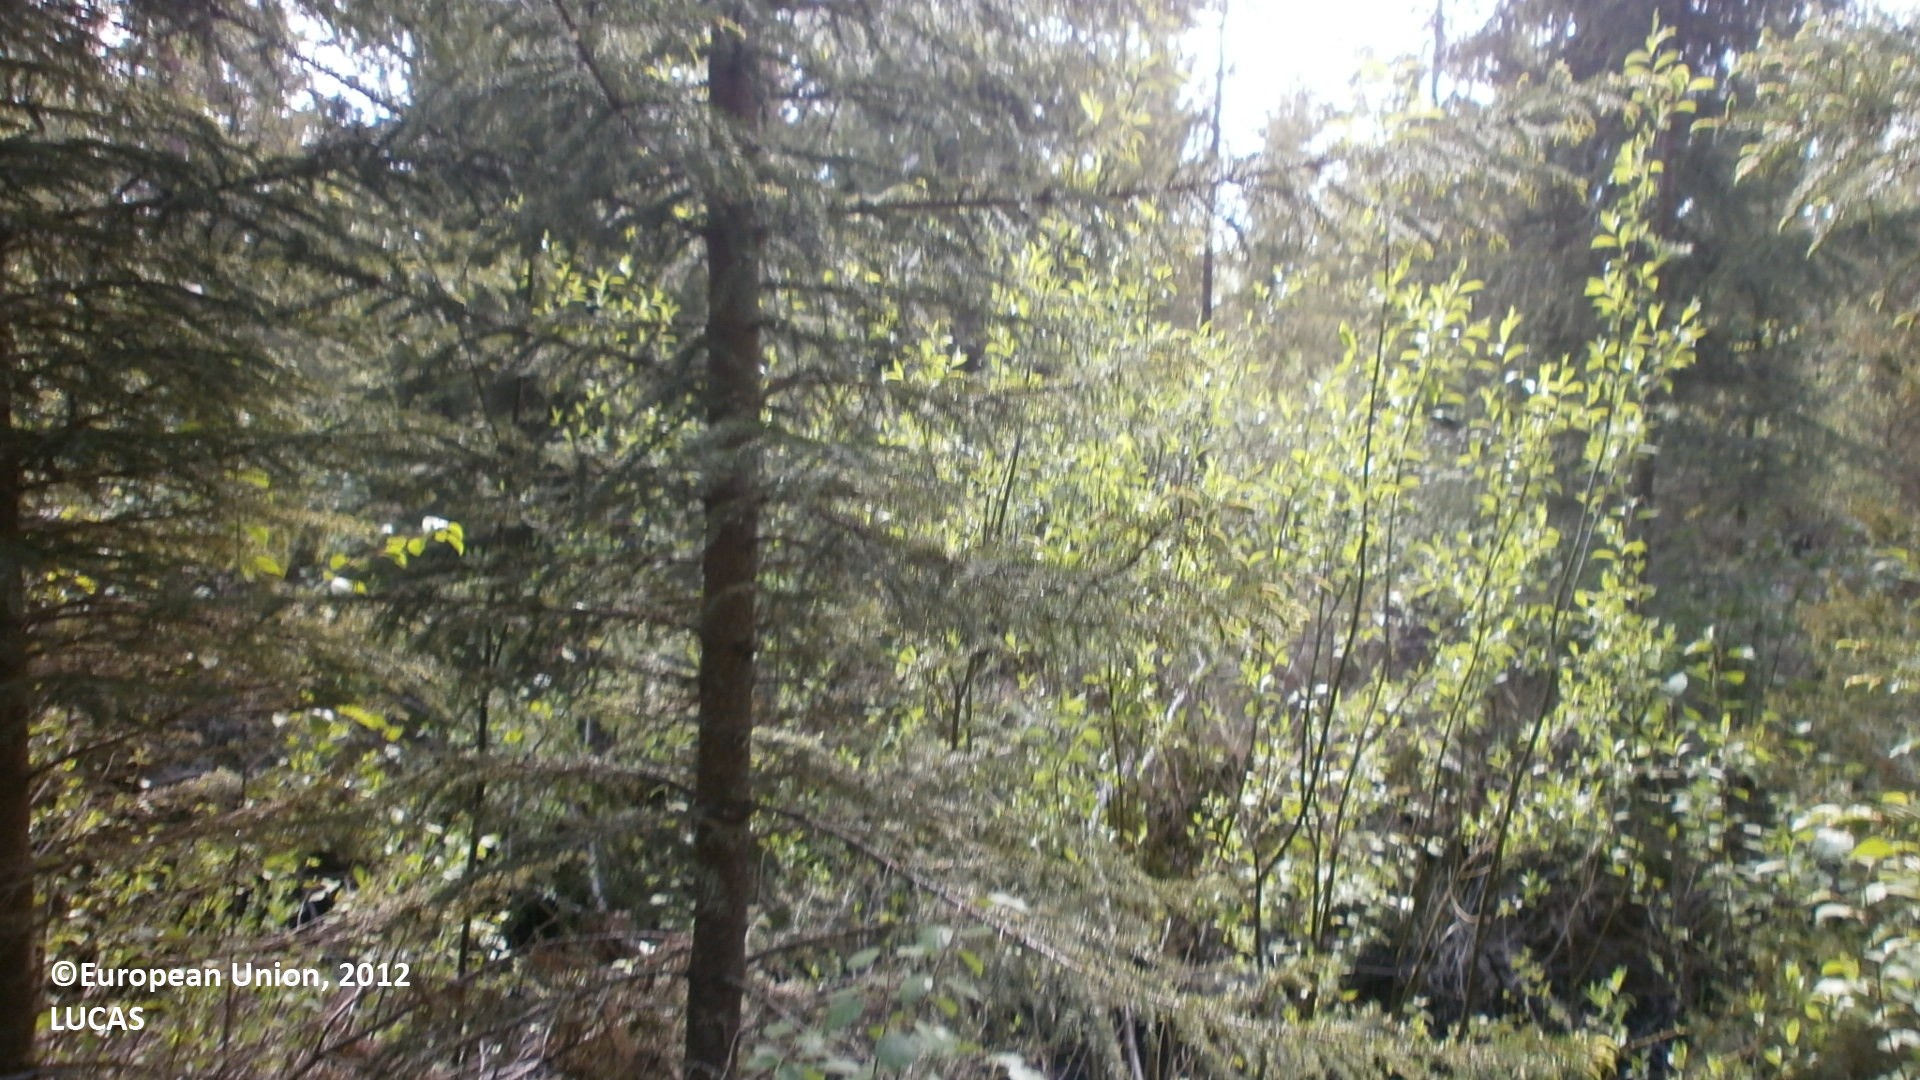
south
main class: Woodland
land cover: Spruce dominated coniferous woodland
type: mire and swamp forests
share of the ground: 50 - 75 %
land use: Forestry
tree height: > 5 m
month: June
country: FI
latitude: 64.5462
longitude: 25.2018
